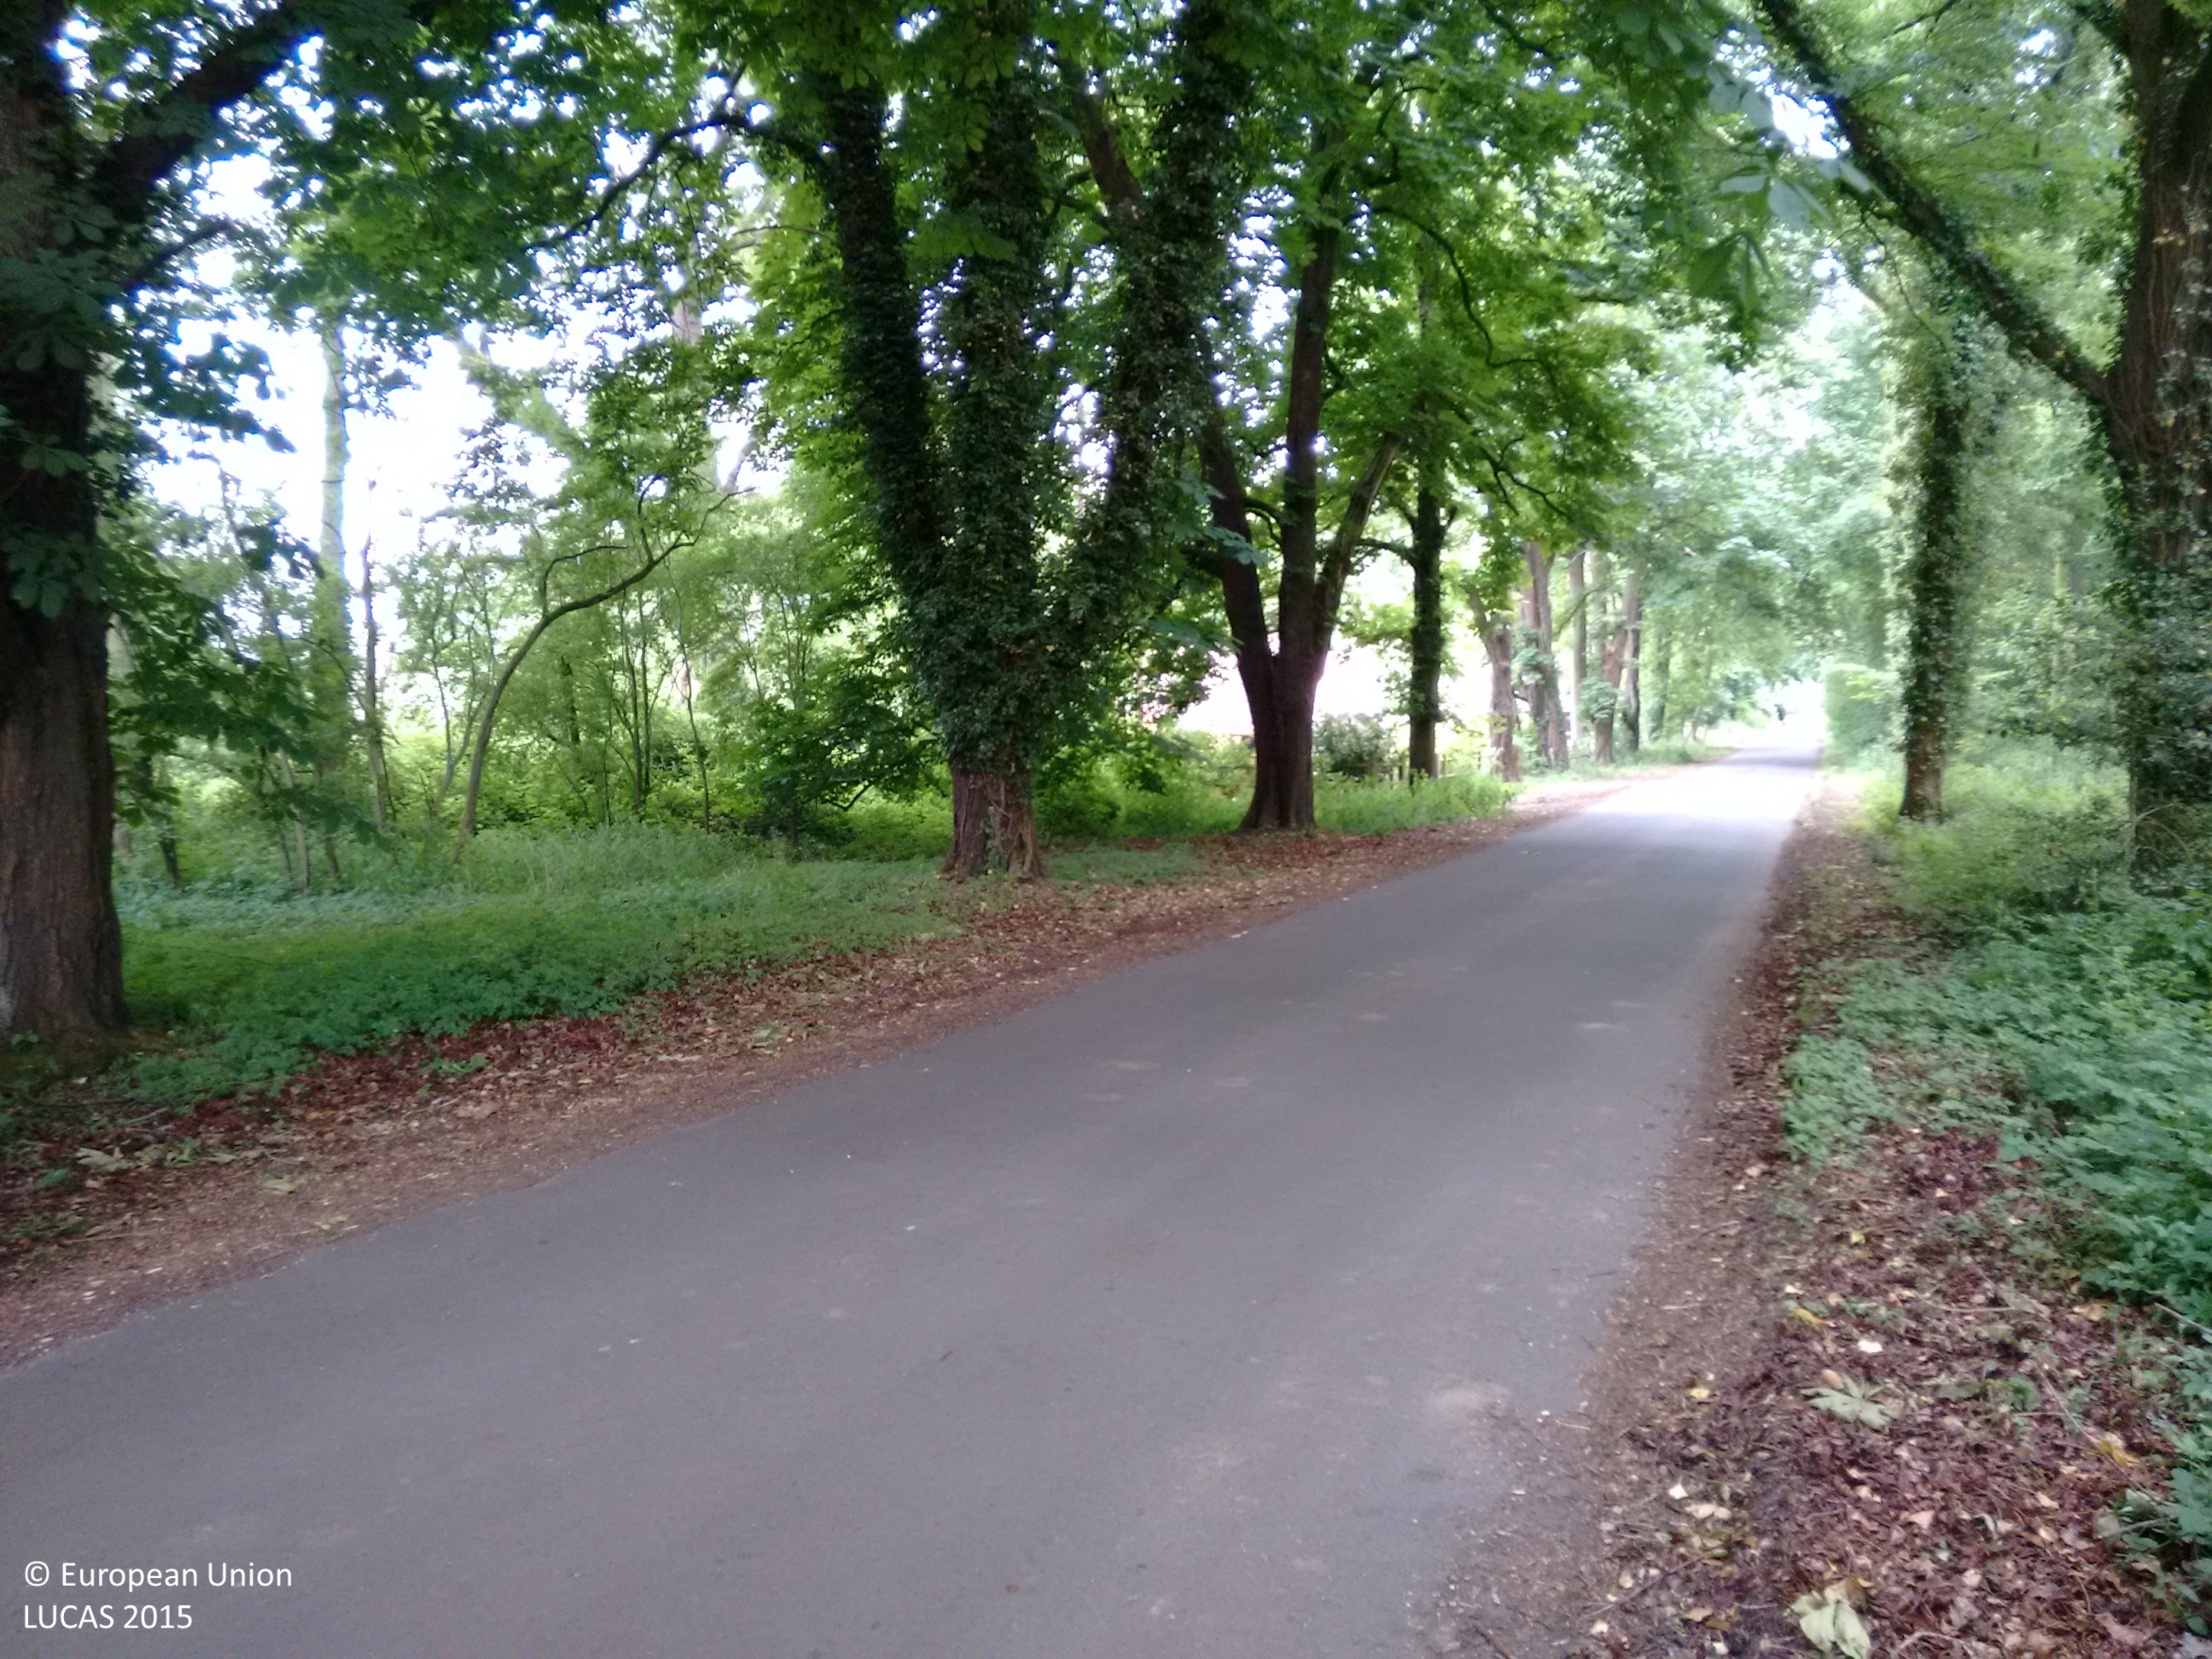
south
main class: Woodland
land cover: Broadleaved woodland
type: mesophytic deciduous forest
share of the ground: > 75 %
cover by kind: broadleaved forest trees 80 %, herbaceous plants 20 %
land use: Semi-natural and natural areas not in use
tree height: > 5 m
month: June
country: GB
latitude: 51.3890
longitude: -1.0384
